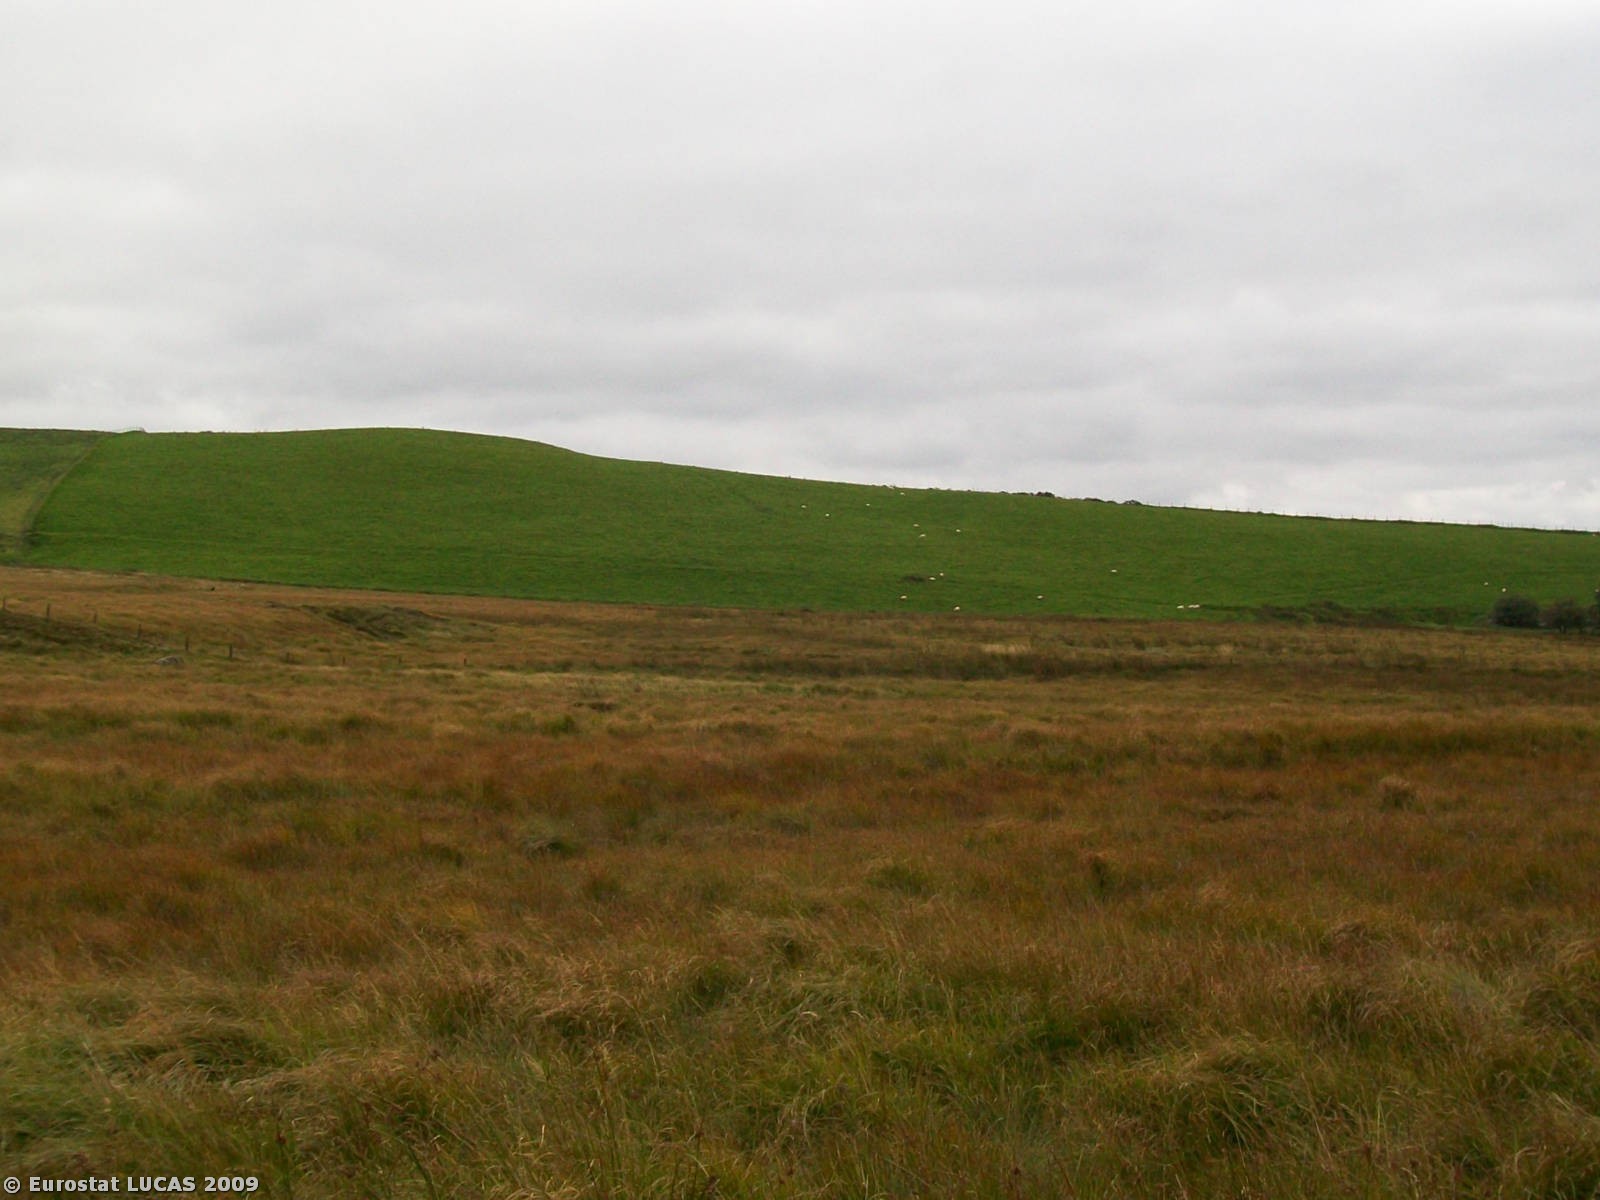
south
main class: Grassland
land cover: Grassland without tree/shrub cover
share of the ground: > 75 %
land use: Agriculture (excluding fallow land and kitchen gardens)
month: September
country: GB
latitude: 52.3105
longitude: -3.8348
